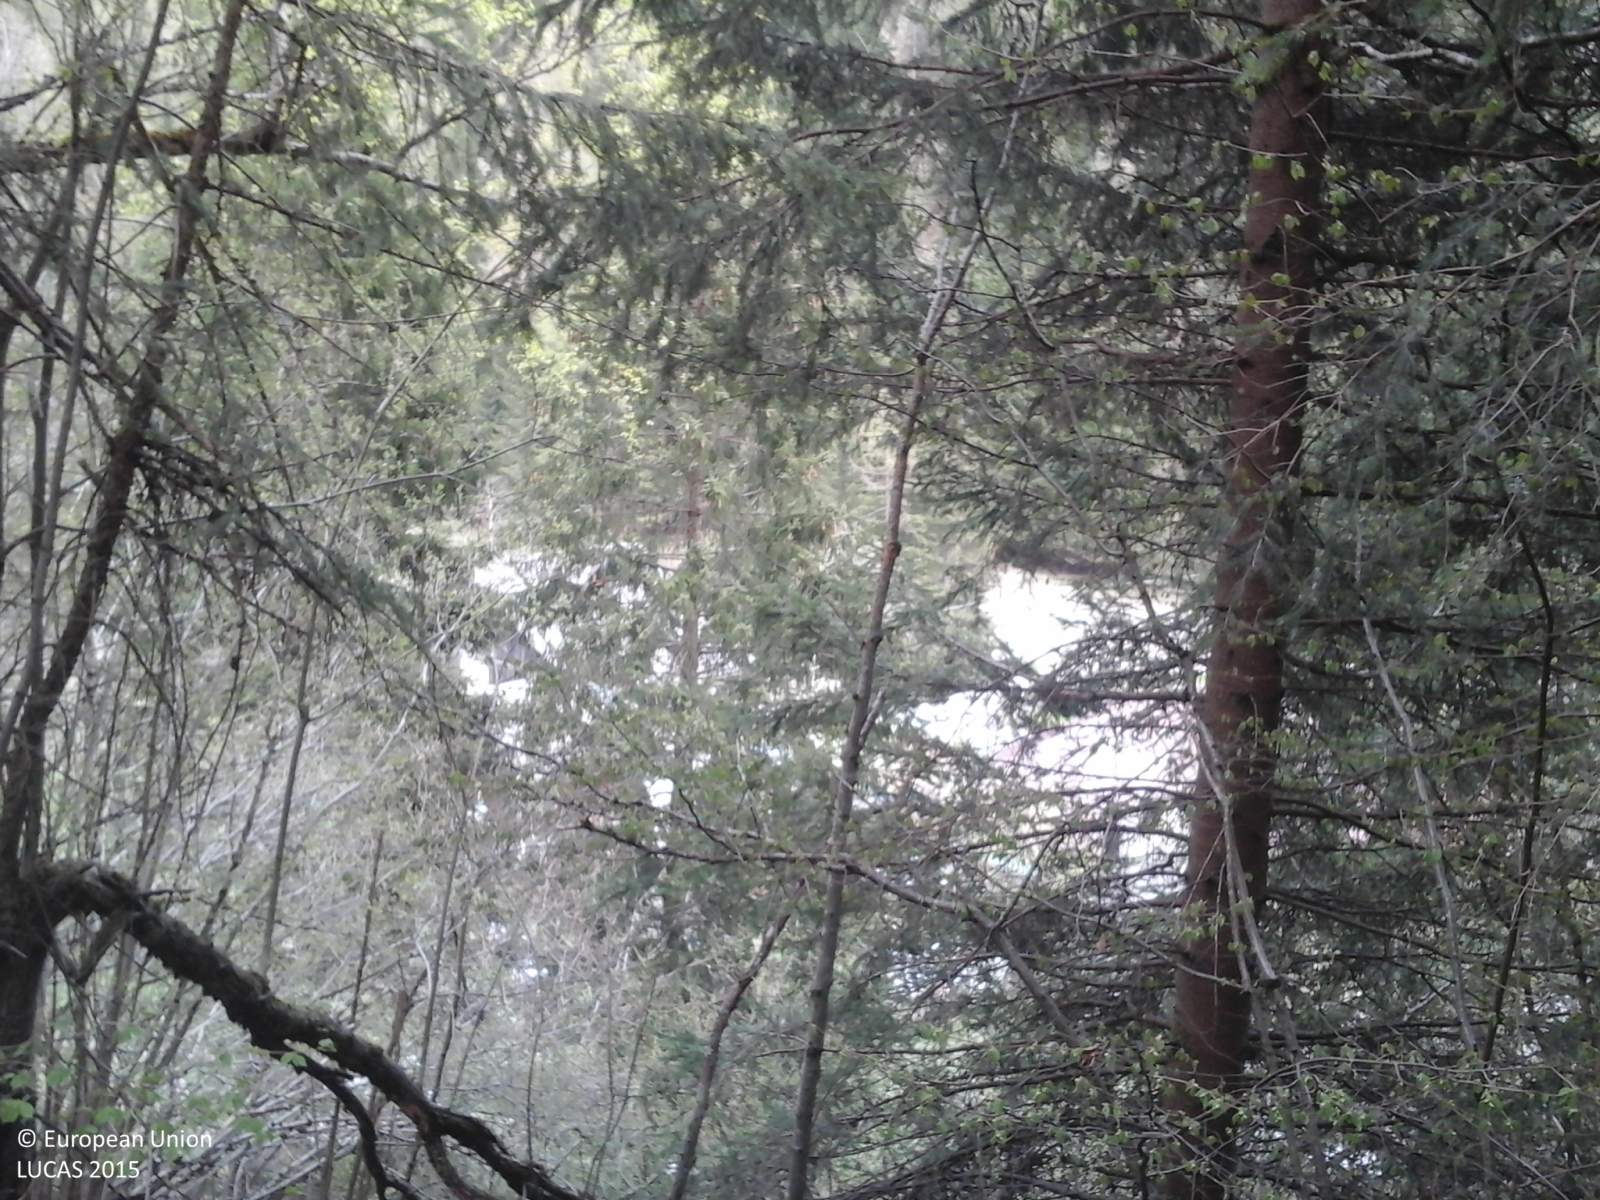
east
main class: Woodland
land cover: Spruce dominated coniferous woodland
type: alpine coniferous forest
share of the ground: > 75 %
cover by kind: coniferous forest trees 90 %, herbaceous plants 10 %
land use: Forestry
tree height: > 5 m
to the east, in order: Spruce dominated coniferous woodland; Electric lines; Spruce dominated coniferous woodland; Artificial constructions in urban areas; Rivers and streams; Paved roads, cycling and walking lanes; Other bare soil; Spruce dominated coniferous woodland; Tracks; Spruce dominated coniferous woodland
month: May
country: IT
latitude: 46.3670
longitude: 10.6880
